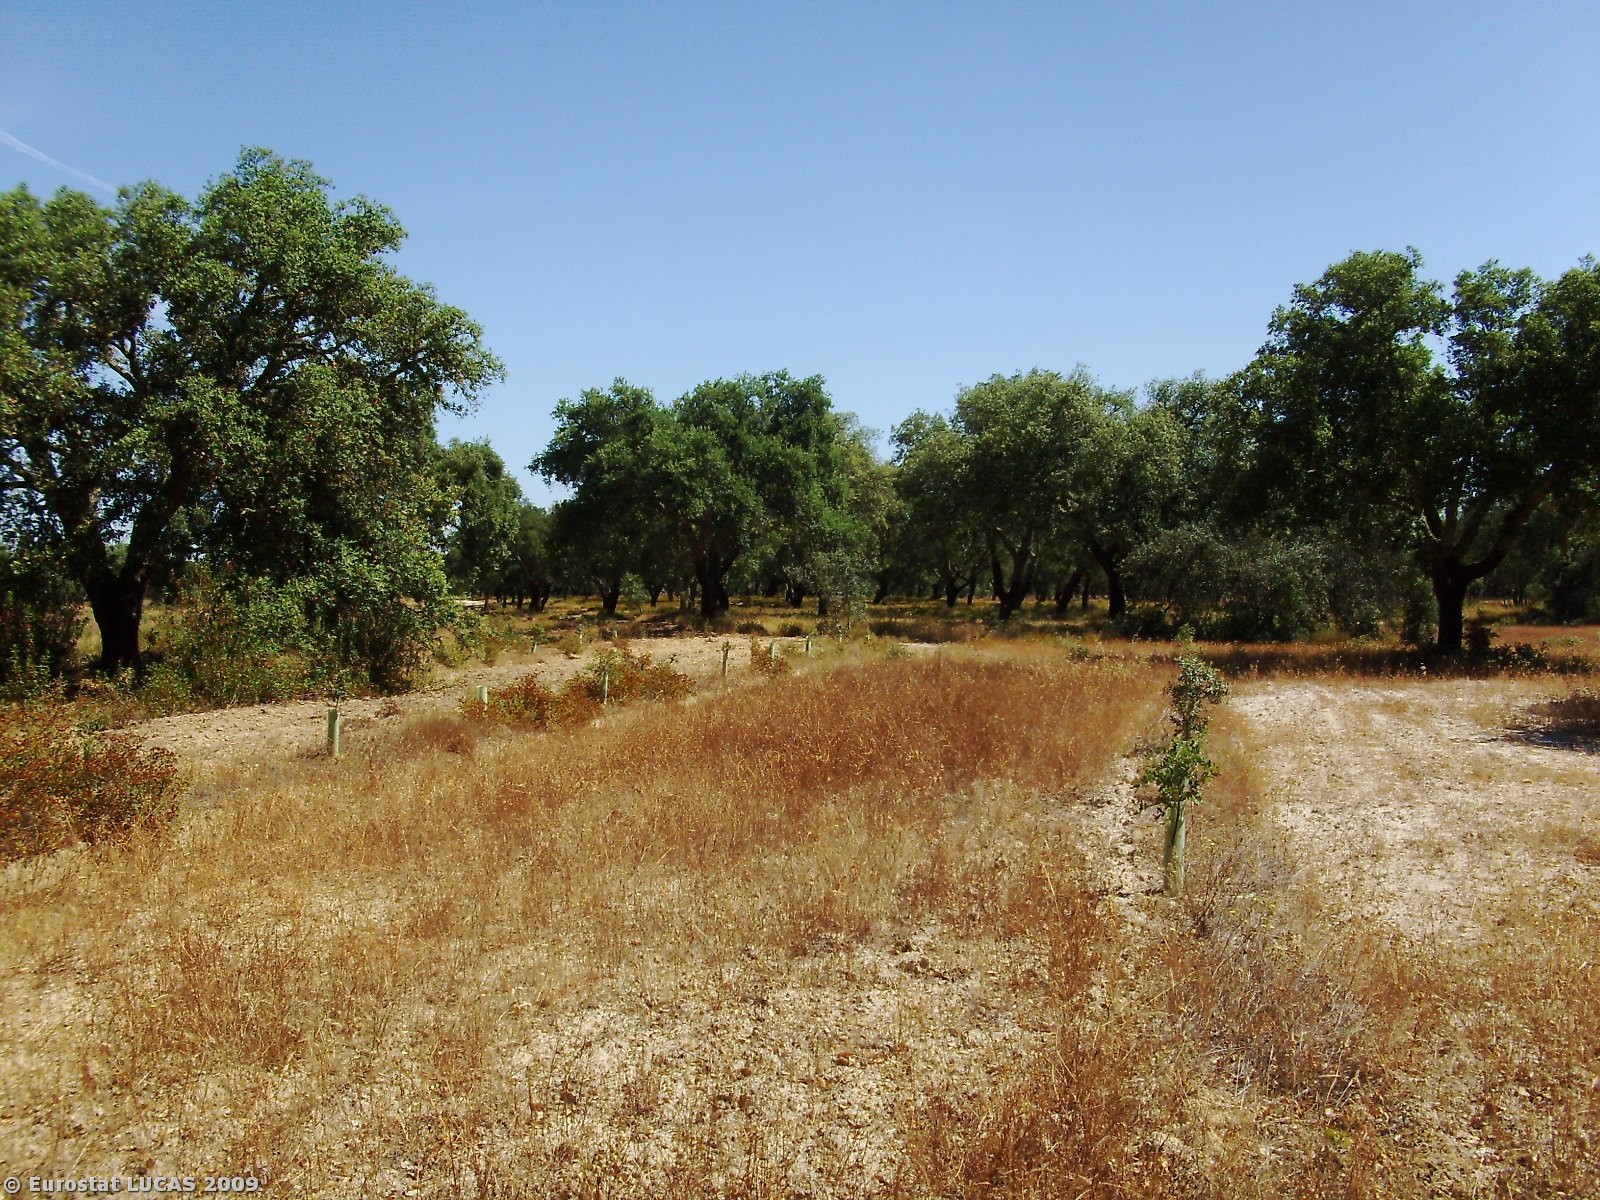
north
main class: Woodland
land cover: Broadleaved woodland
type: broadleaved evergreen forest
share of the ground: 25 - 50 %
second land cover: Spontaneously vegetated surfaces
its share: 25 - 50 %
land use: Forestry
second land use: Fallow land
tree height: > 5 m
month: July
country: PT
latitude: 37.7886
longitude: -8.3977
